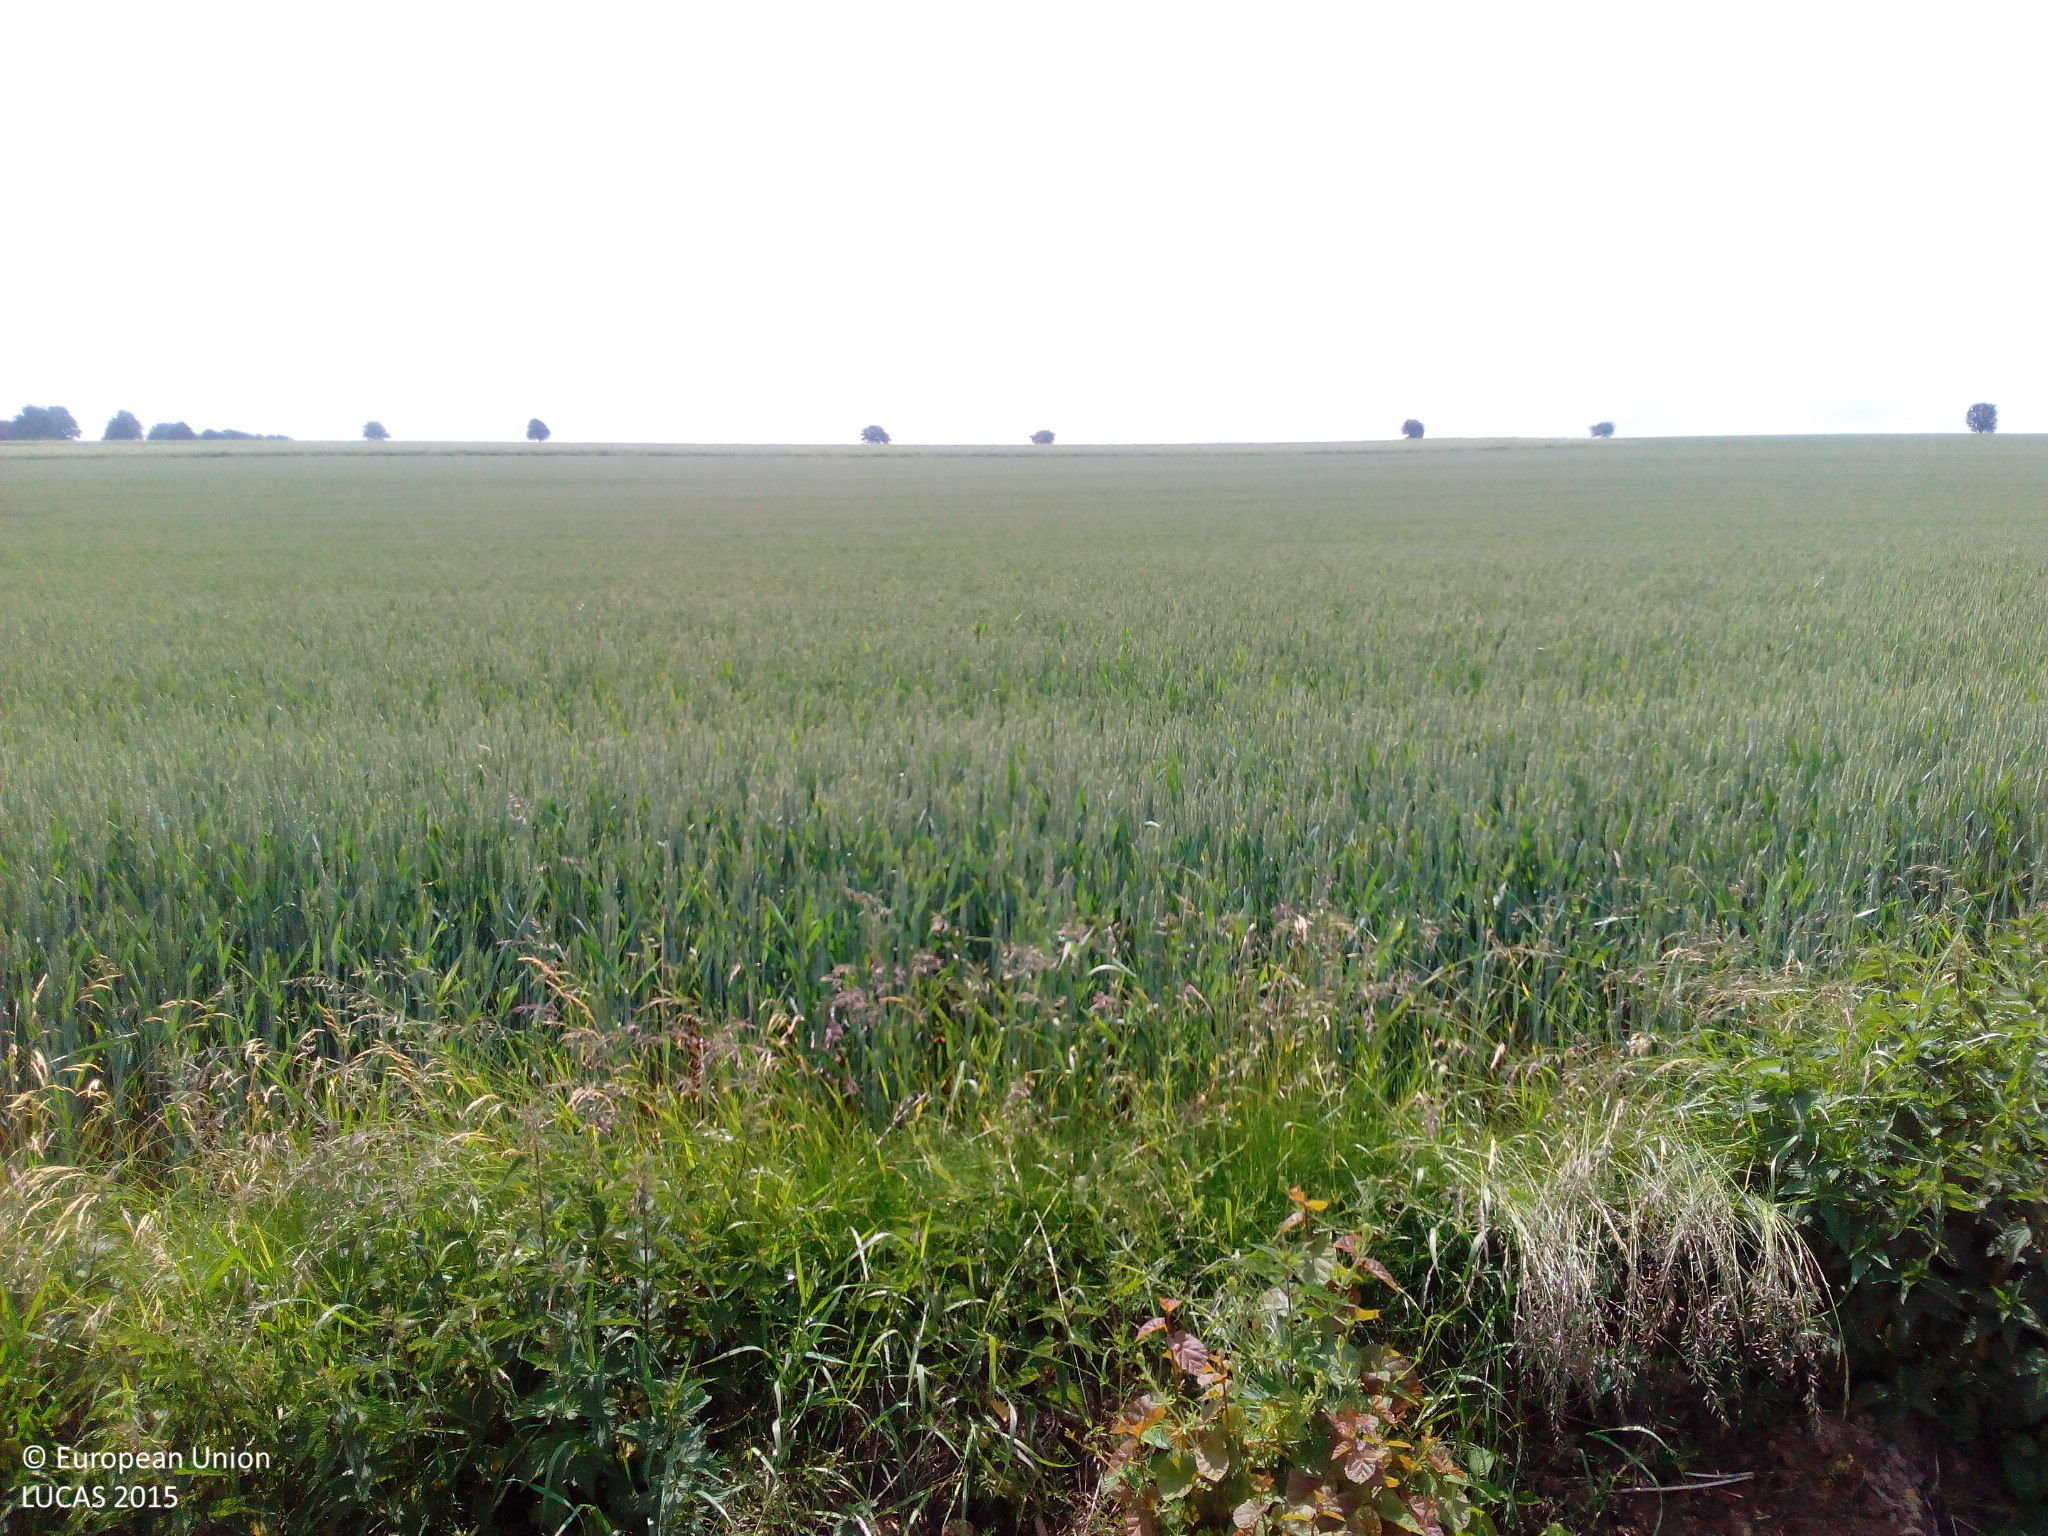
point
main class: Cropland
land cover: Common wheat
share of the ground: > 75 %
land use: Agriculture (excluding fallow land and kitchen gardens)
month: June
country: DE
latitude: 51.5225
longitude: 8.4582
